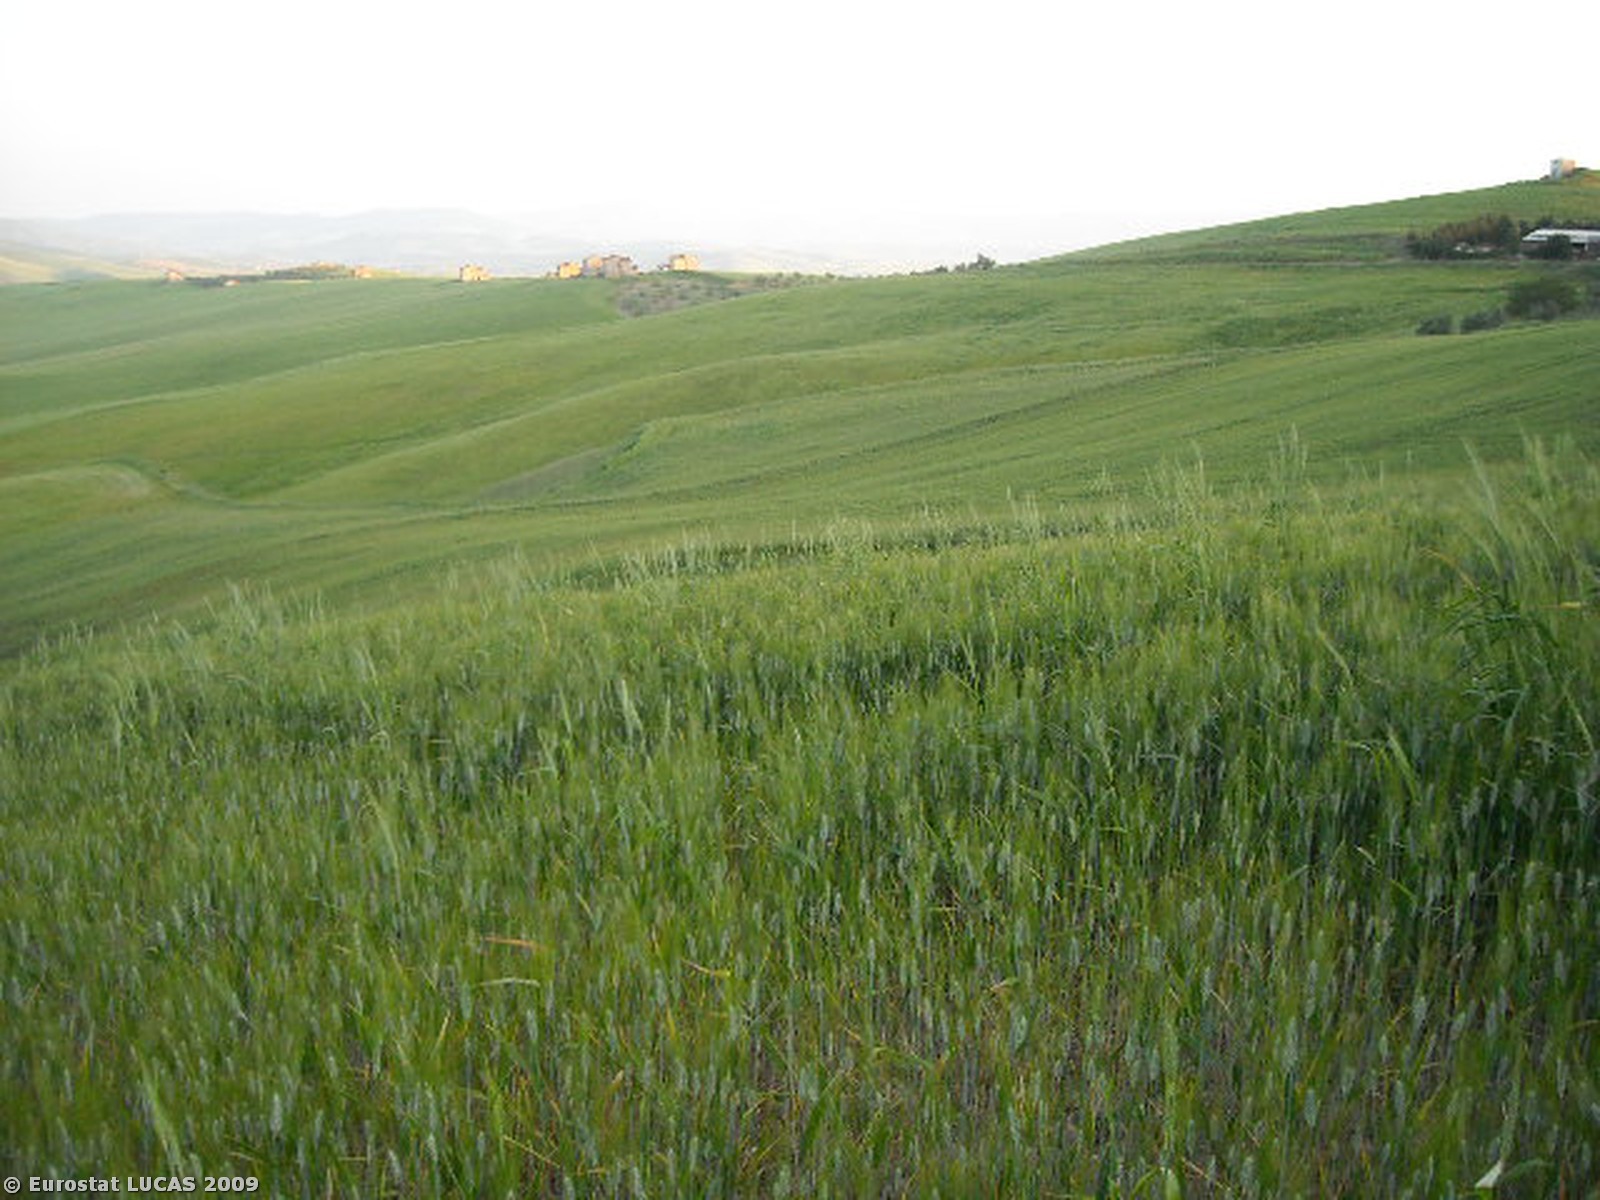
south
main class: Cropland
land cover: Durum wheat
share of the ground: > 75 %
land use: Agriculture (excluding fallow land and kitchen gardens)
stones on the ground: 10 - 25 %
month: May
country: IT
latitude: 40.8538
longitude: 16.1586
